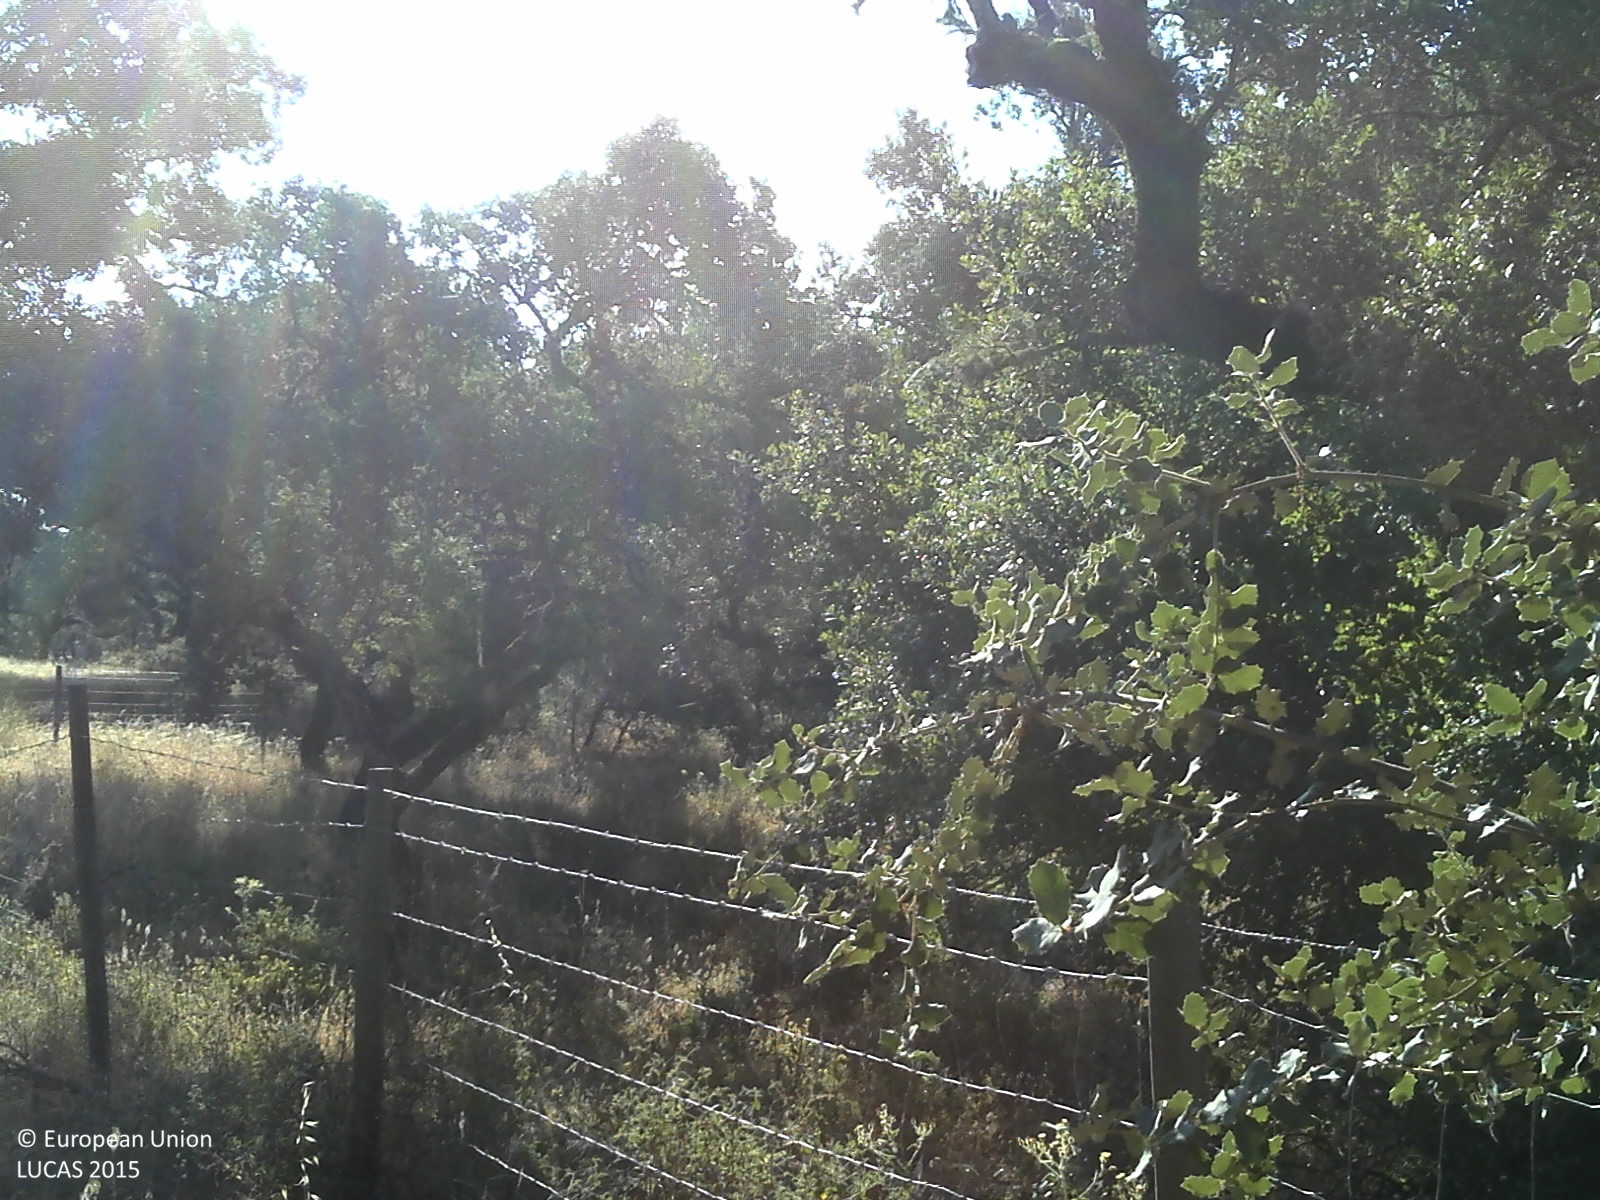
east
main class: Woodland
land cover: Broadleaved woodland
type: broadleaved evergreen forest
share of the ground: > 75 %
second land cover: Other leguminous and mixtures for fodder
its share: > 75 %
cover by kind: broadleaved forest trees 75 %, herbaceous plants 25 %
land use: Forestry
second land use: Agriculture (excluding fallow land and kitchen gardens)
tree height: > 5 m
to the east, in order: Broadleaved woodland; Other leguminous and mixtures for fodder; Broadleaved woodland
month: June
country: PT
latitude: 38.6647
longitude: -8.0774
